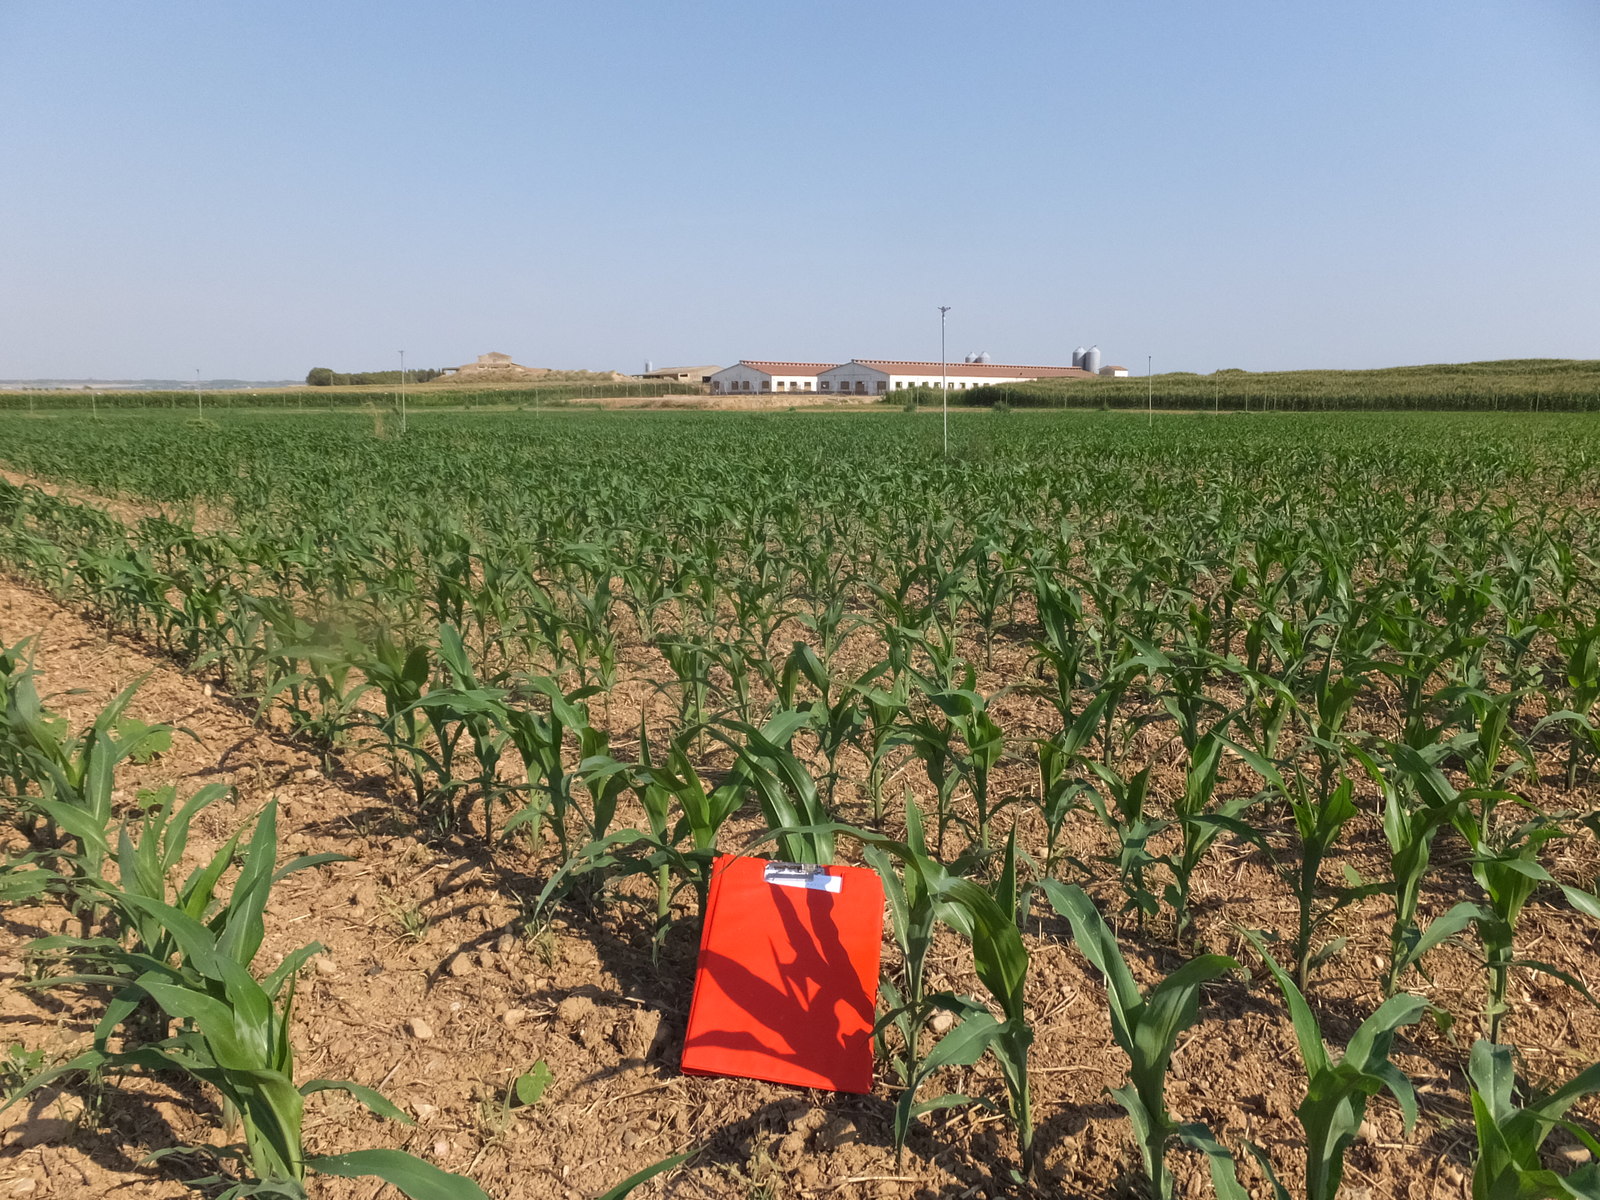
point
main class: Cropland
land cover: Maize
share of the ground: 10 - 25 %
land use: Agriculture (excluding fallow land and kitchen gardens)
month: July
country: ES
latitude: 41.7157
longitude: 0.3097
